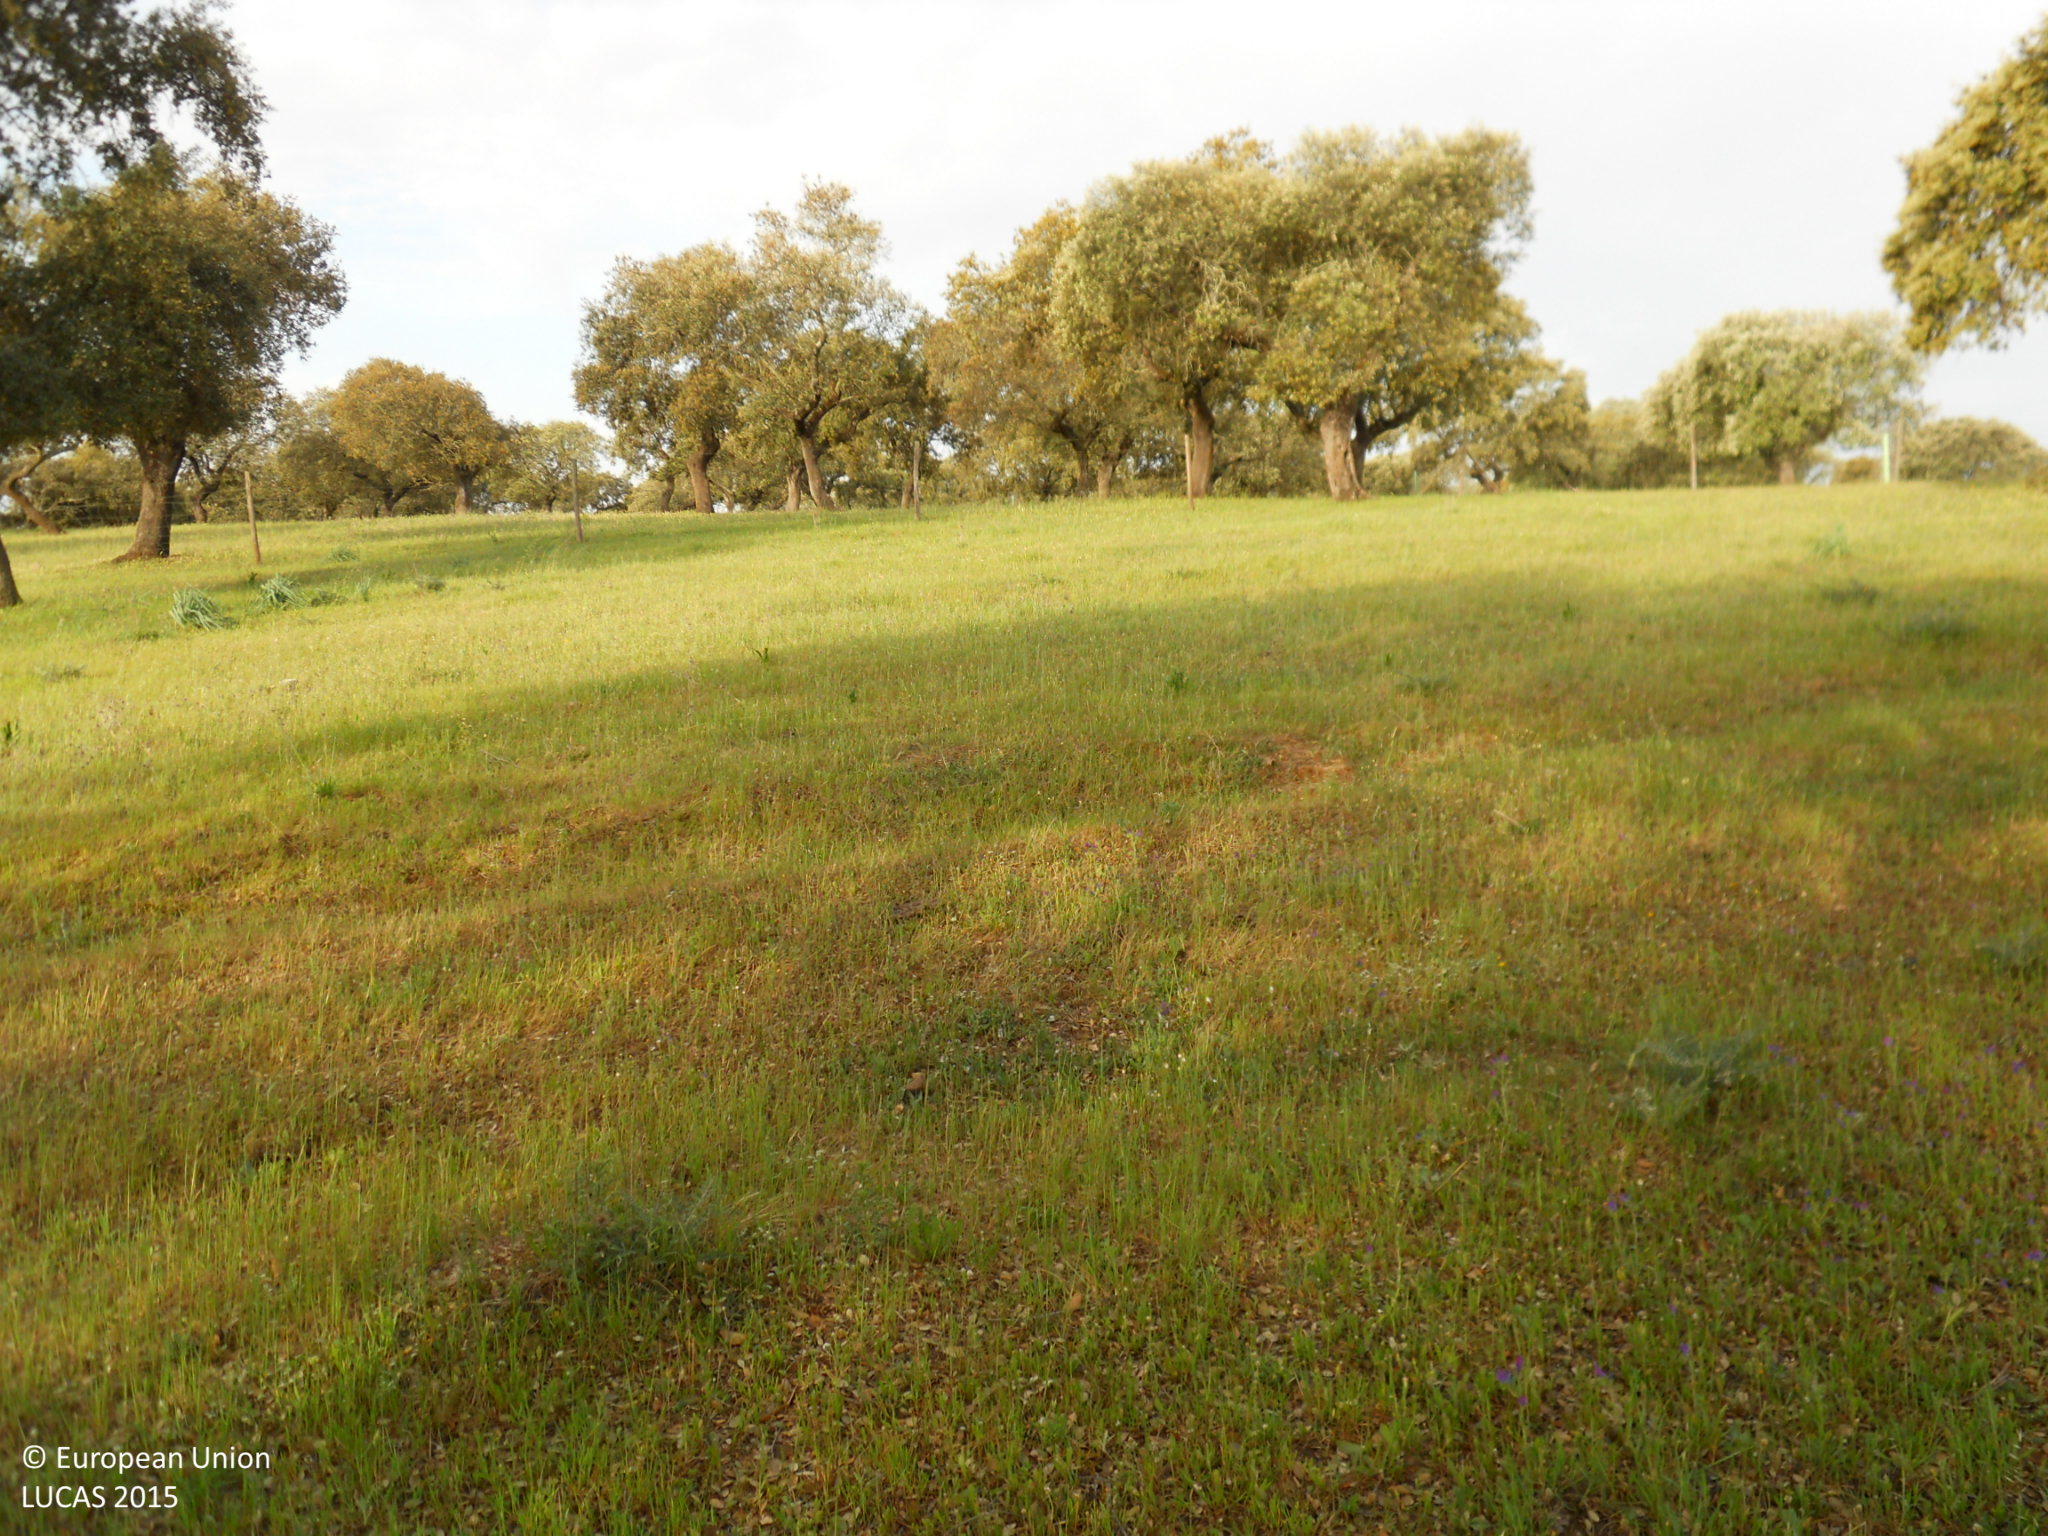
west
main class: Woodland
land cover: Broadleaved woodland
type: broadleaved evergreen forest
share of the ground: 50 - 75 %
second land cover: Grassland without tree/shrub cover
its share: > 75 %
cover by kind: broadleaved forest trees 50 %, herbaceous plants 50 %
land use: Forestry
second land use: Agriculture (excluding fallow land and kitchen gardens)
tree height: > 5 m
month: April
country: ES
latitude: 39.0744
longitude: -6.5356
